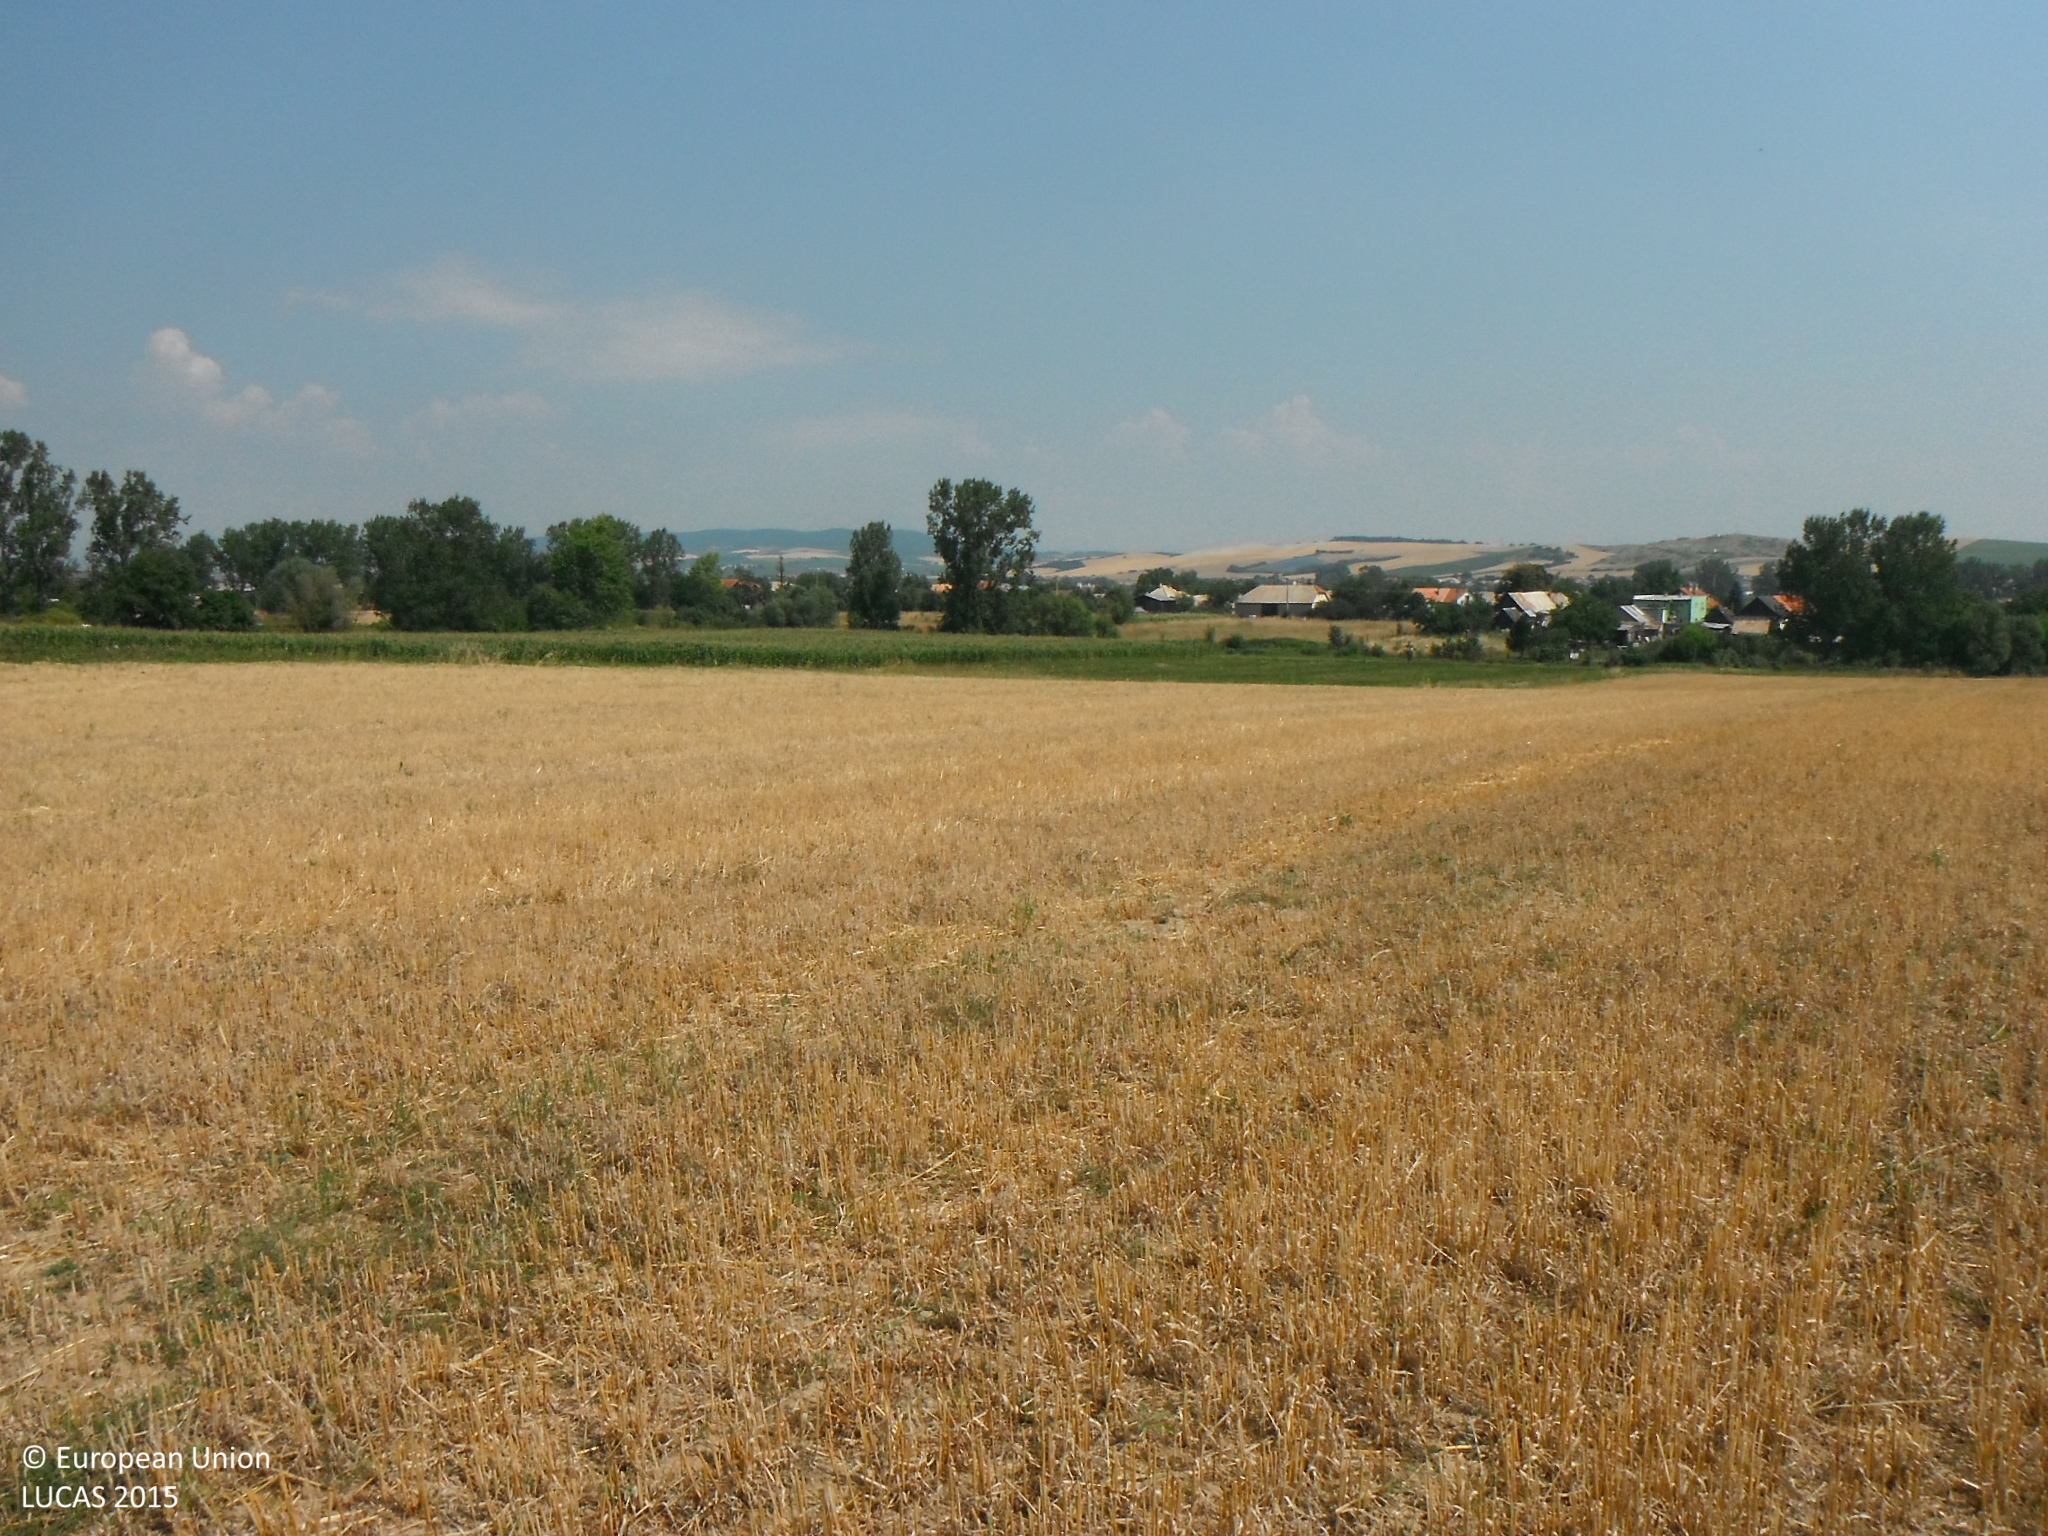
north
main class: Cropland
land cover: Barley
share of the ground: > 75 %
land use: Agriculture (excluding fallow land and kitchen gardens)
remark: Harvested field
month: July
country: SK
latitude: 48.3251
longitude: 20.0507
